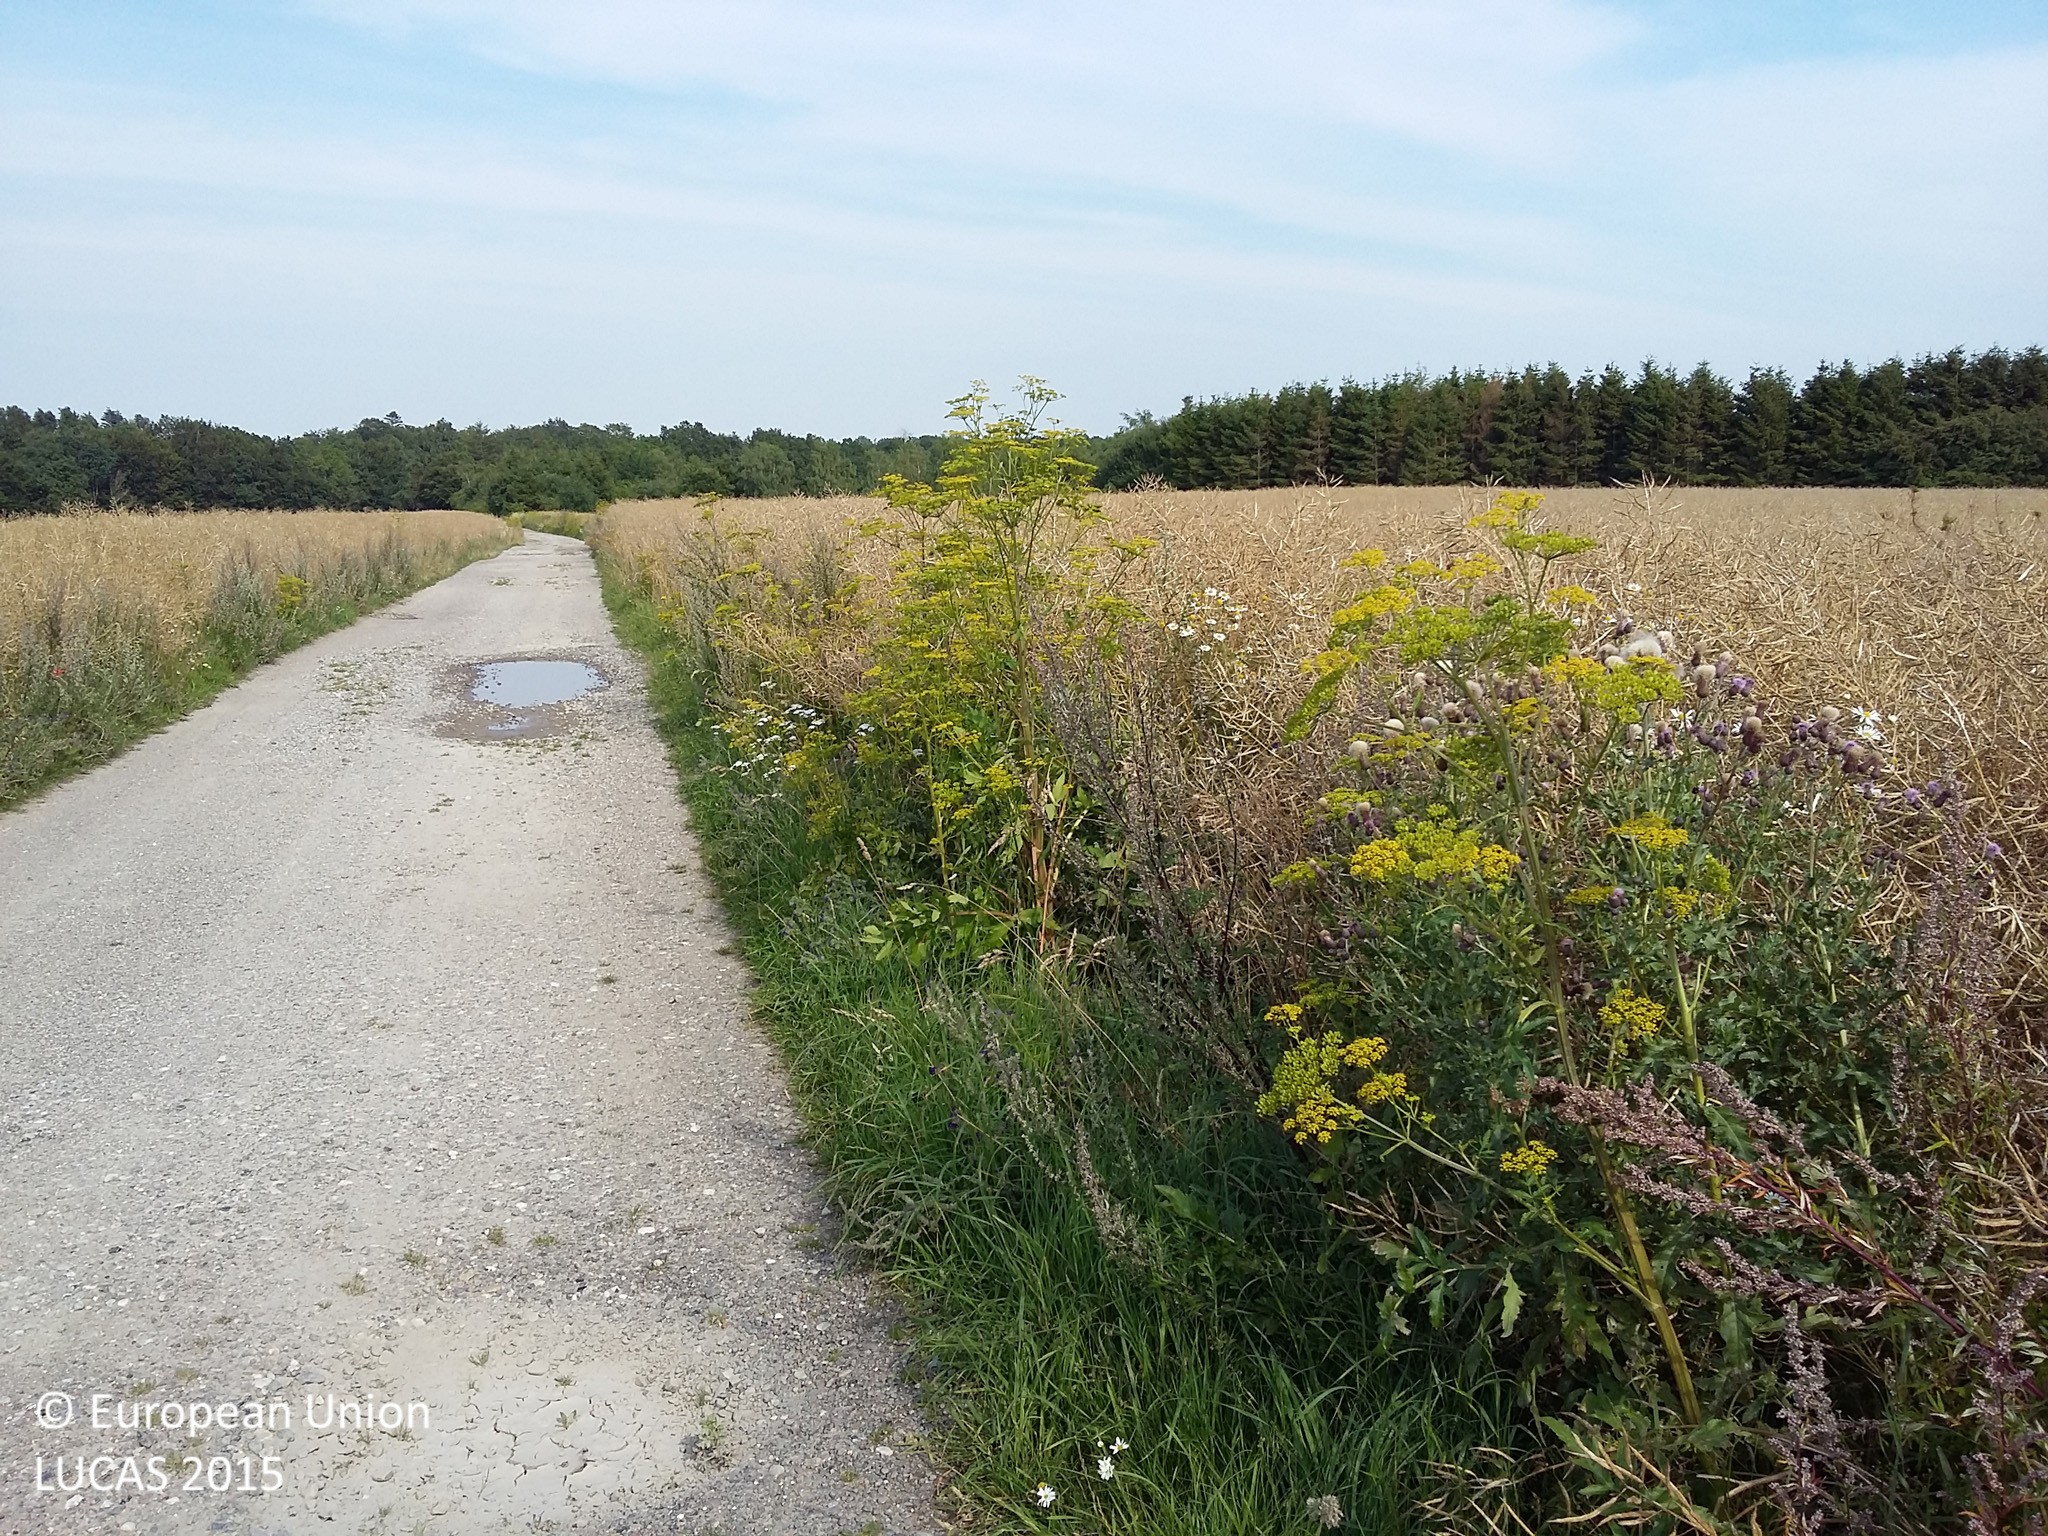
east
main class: Cropland
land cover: Rape and turnip rape
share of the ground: > 75 %
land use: Agriculture (excluding fallow land and kitchen gardens)
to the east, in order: Rape and turnip rape; Spruce dominated coniferous woodland; Broadleaved woodland; Tracks; Broadleaved woodland; Inland marshes; Inland fresh water bodies
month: August
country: DK
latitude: 55.5082
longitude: 11.9143
